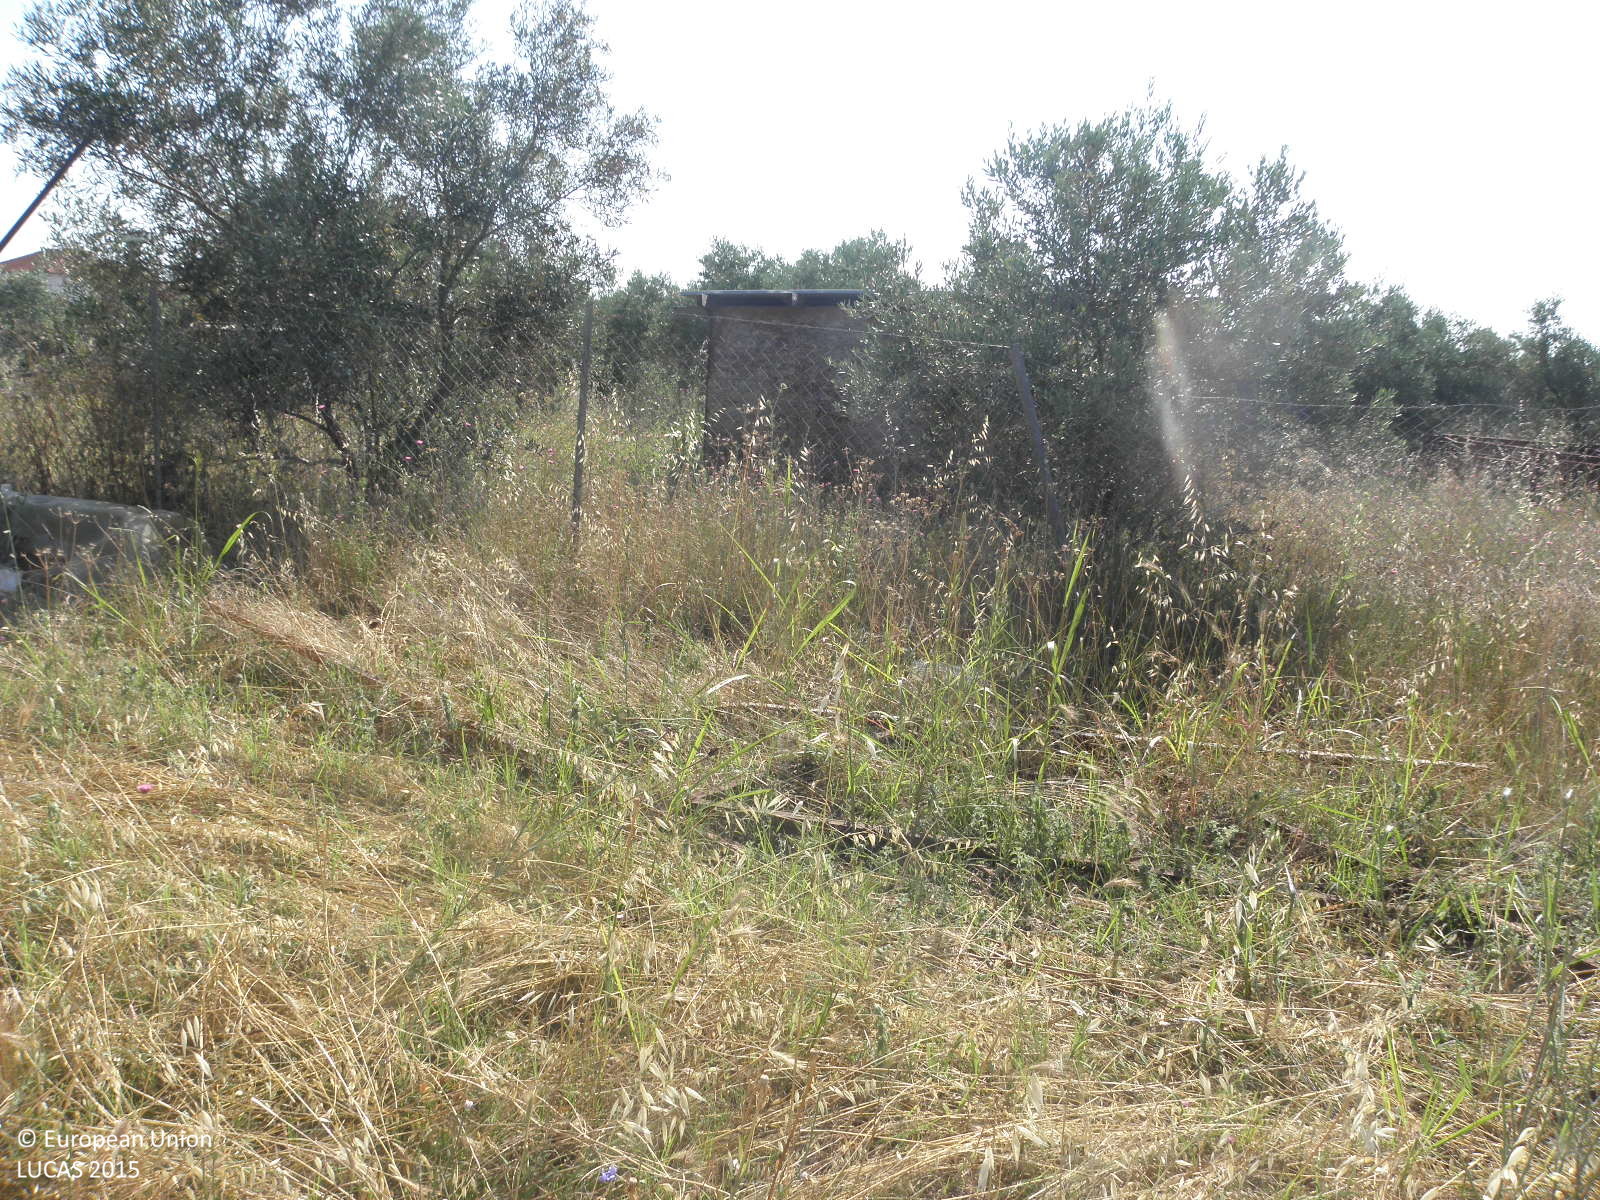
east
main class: Grassland
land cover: Spontaneously vegetated surfaces
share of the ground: > 75 %
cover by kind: herbaceous plants 100 %
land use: Fallow land
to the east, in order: Spontaneously vegetated surfaces; Fences; Olive groves; Artificial constructions in urban areas; Grassland without tree/shrub cover; Fences; Olive groves; Fences; Spontaneously vegetated surfaces; Tracks; Fences; Grassland without tree/shrub cover; Artificial constructions in urban areas; Abandoned hedges; Fences; Spontaneously vegetated surfaces; Abandoned hedges; Fences; Electric lines; Shruby margins; Paved roads, cycling and walking lanes; Ditches and canals; Abandoned hedges; Fences; Grassland without tree/shrub cover; Artificial constructions in urban areas; Grassland without tree/shrub cover
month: June
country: GR
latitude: 40.2038
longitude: 22.4381
